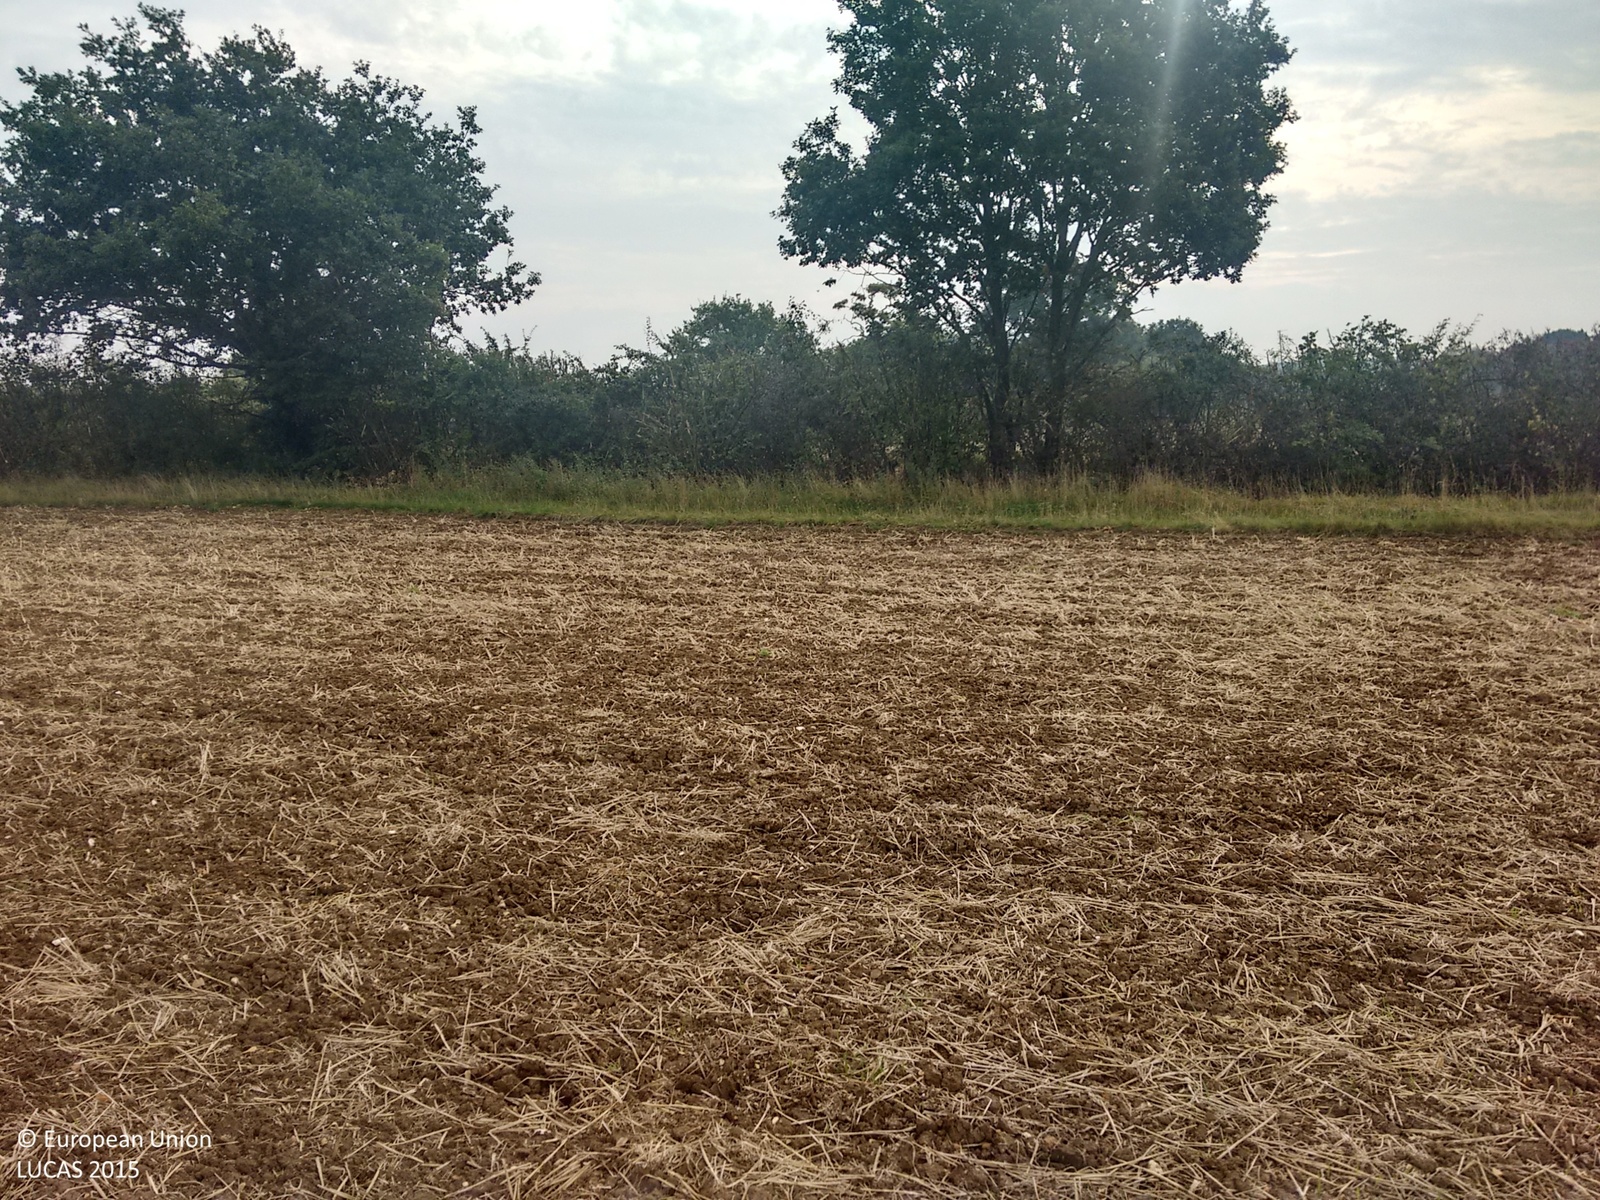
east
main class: Cropland
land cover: Oats
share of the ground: 25 - 50 %
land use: Agriculture (excluding fallow land and kitchen gardens)
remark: Harvested field
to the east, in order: Oats; Grass margins; Managed hedges; Ditches and canals; Grass margins; Common wheat; Grass margins; Managed hedges; Ditches and canals; Managed hedges; Grass margins; Barley; Grass margins; Managed hedges; Ditches and canals; Managed hedges; Grass margins; Common wheat
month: September
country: GB
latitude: 51.9049
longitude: 0.2752
